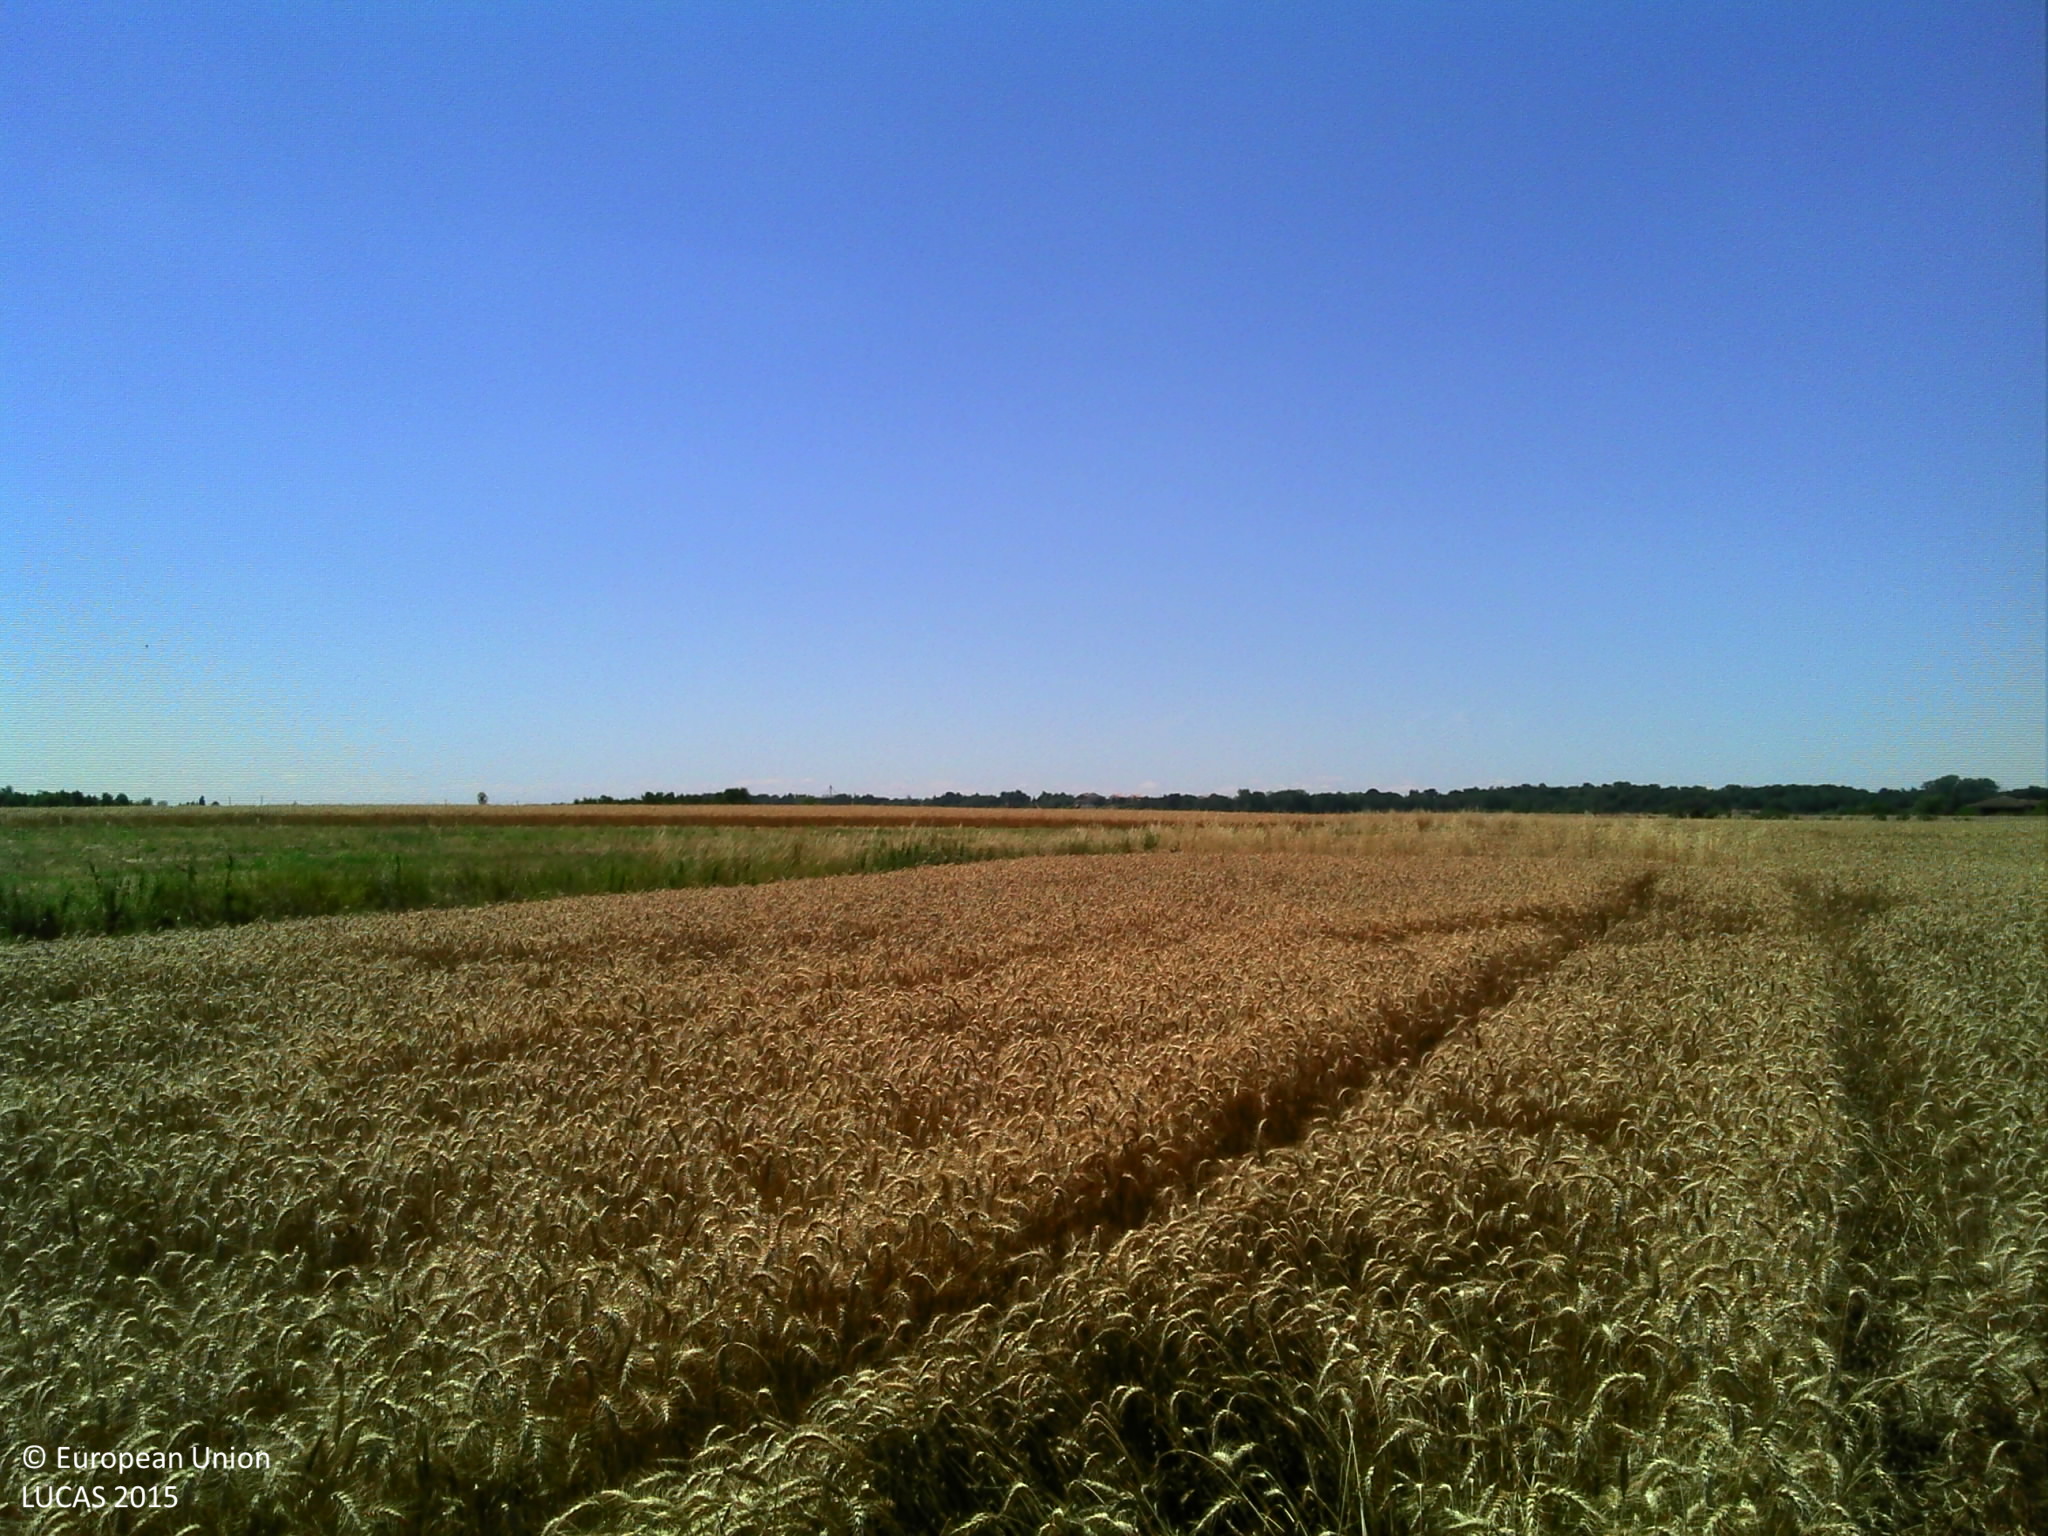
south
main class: Cropland
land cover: Durum wheat
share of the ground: > 75 %
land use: Agriculture (excluding fallow land and kitchen gardens)
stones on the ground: < 10 %
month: June
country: FR
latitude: 43.7485
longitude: 1.2957
